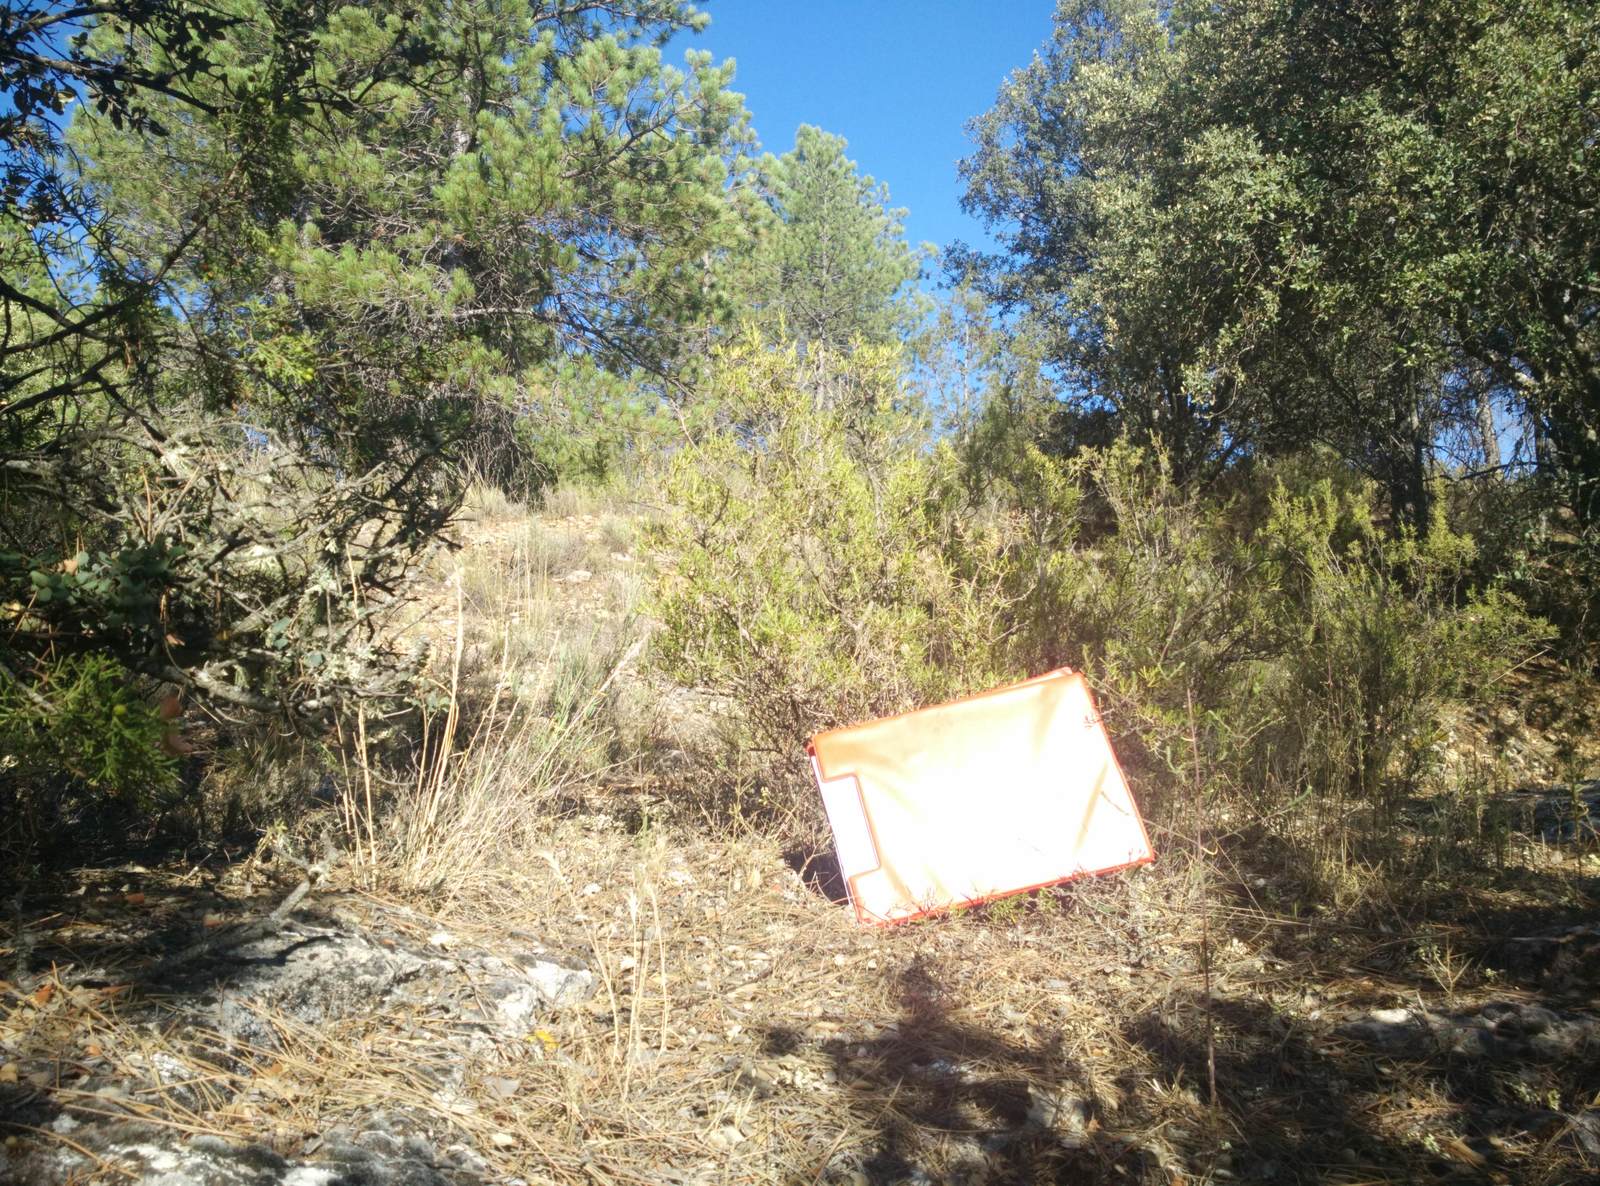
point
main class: Woodland
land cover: Pine dominated mixed woodland
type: coniferous forest of the mediterranean region
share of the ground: > 75 %
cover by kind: coniferous forest trees 45 %, broadleaved forest trees 30 %, unconsolidated bare surface 15 %, shrubs 10 %
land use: Forestry
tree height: > 5 m
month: July
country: ES
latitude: 40.7738
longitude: -2.6952
